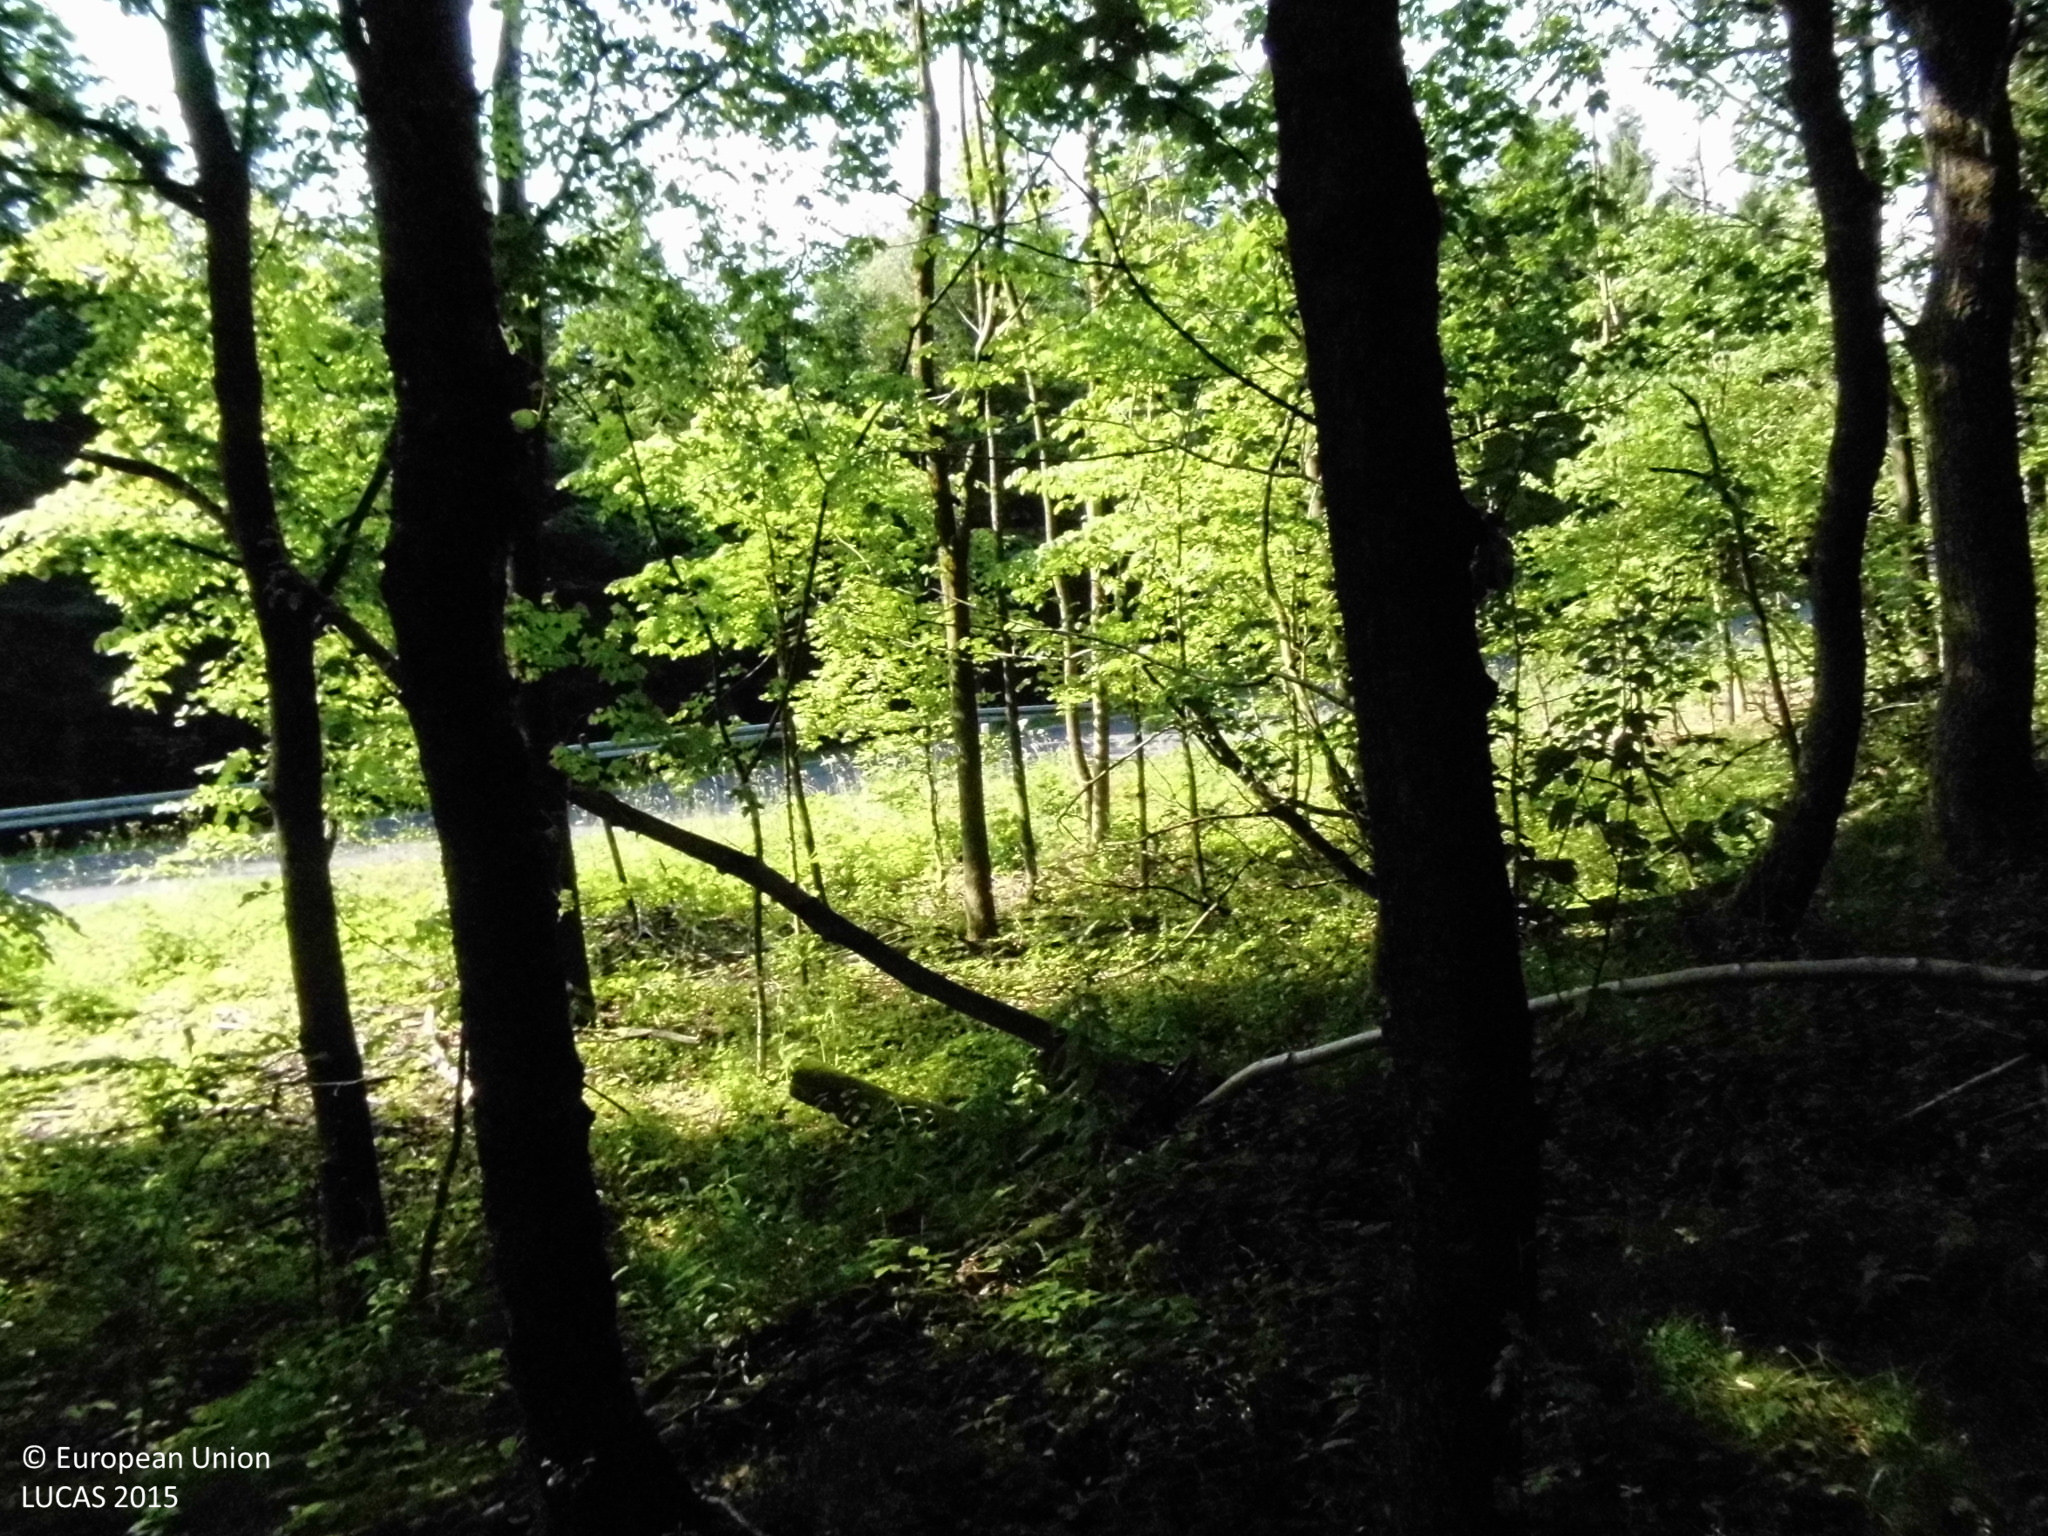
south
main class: Woodland
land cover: Broadleaved woodland
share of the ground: > 75 %
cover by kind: broadleaved forest trees 95 %, herbaceous plants 5 %
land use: Forestry
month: July
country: DE
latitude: 51.2455
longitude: 7.9804
